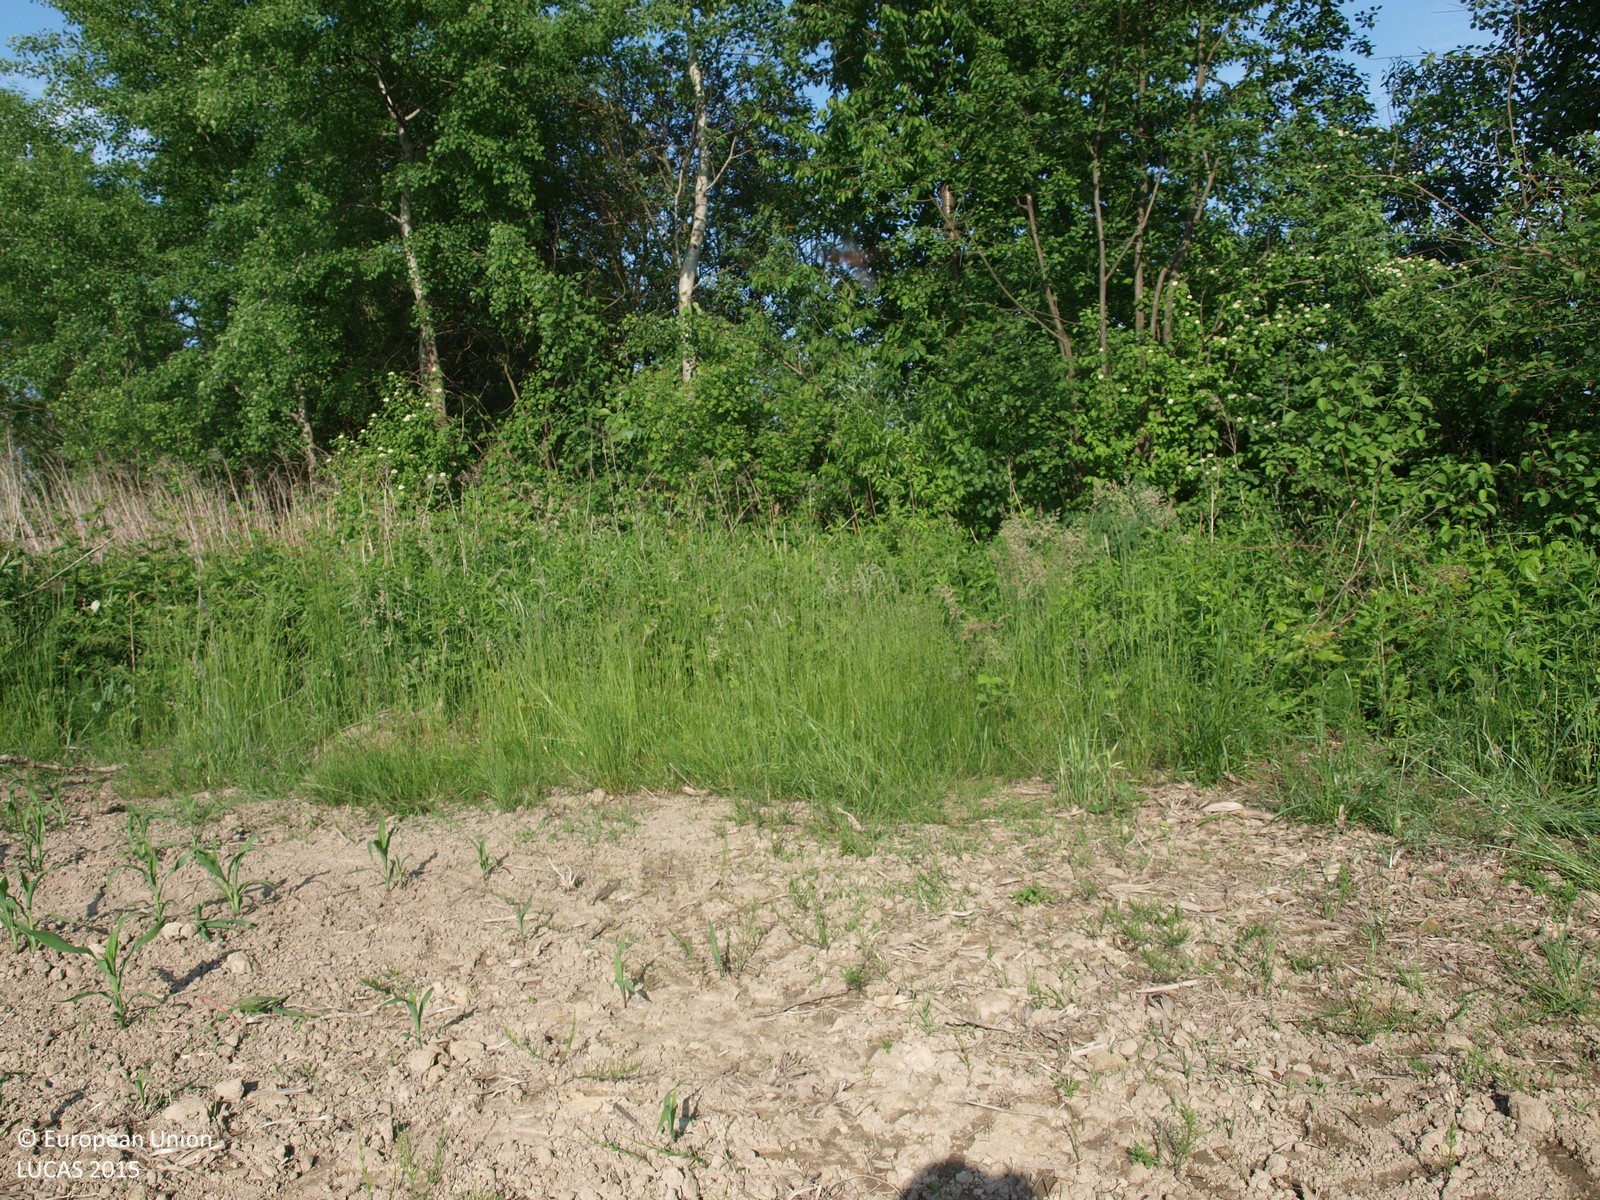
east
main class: Cropland
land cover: Maize
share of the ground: 25 - 50 %
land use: Agriculture (excluding fallow land and kitchen gardens)
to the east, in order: Maize; Abandoned hedges; Ditches and canals; Abandoned hedges; Spontaneously vegetated surfaces; Grassland without tree/shrub cover; Maize; Grassland without tree/shrub cover; Maize; Grassland without tree/shrub cover; Maize; Grassland without tree/shrub cover
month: May
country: HR
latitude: 46.2608
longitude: 16.2140
